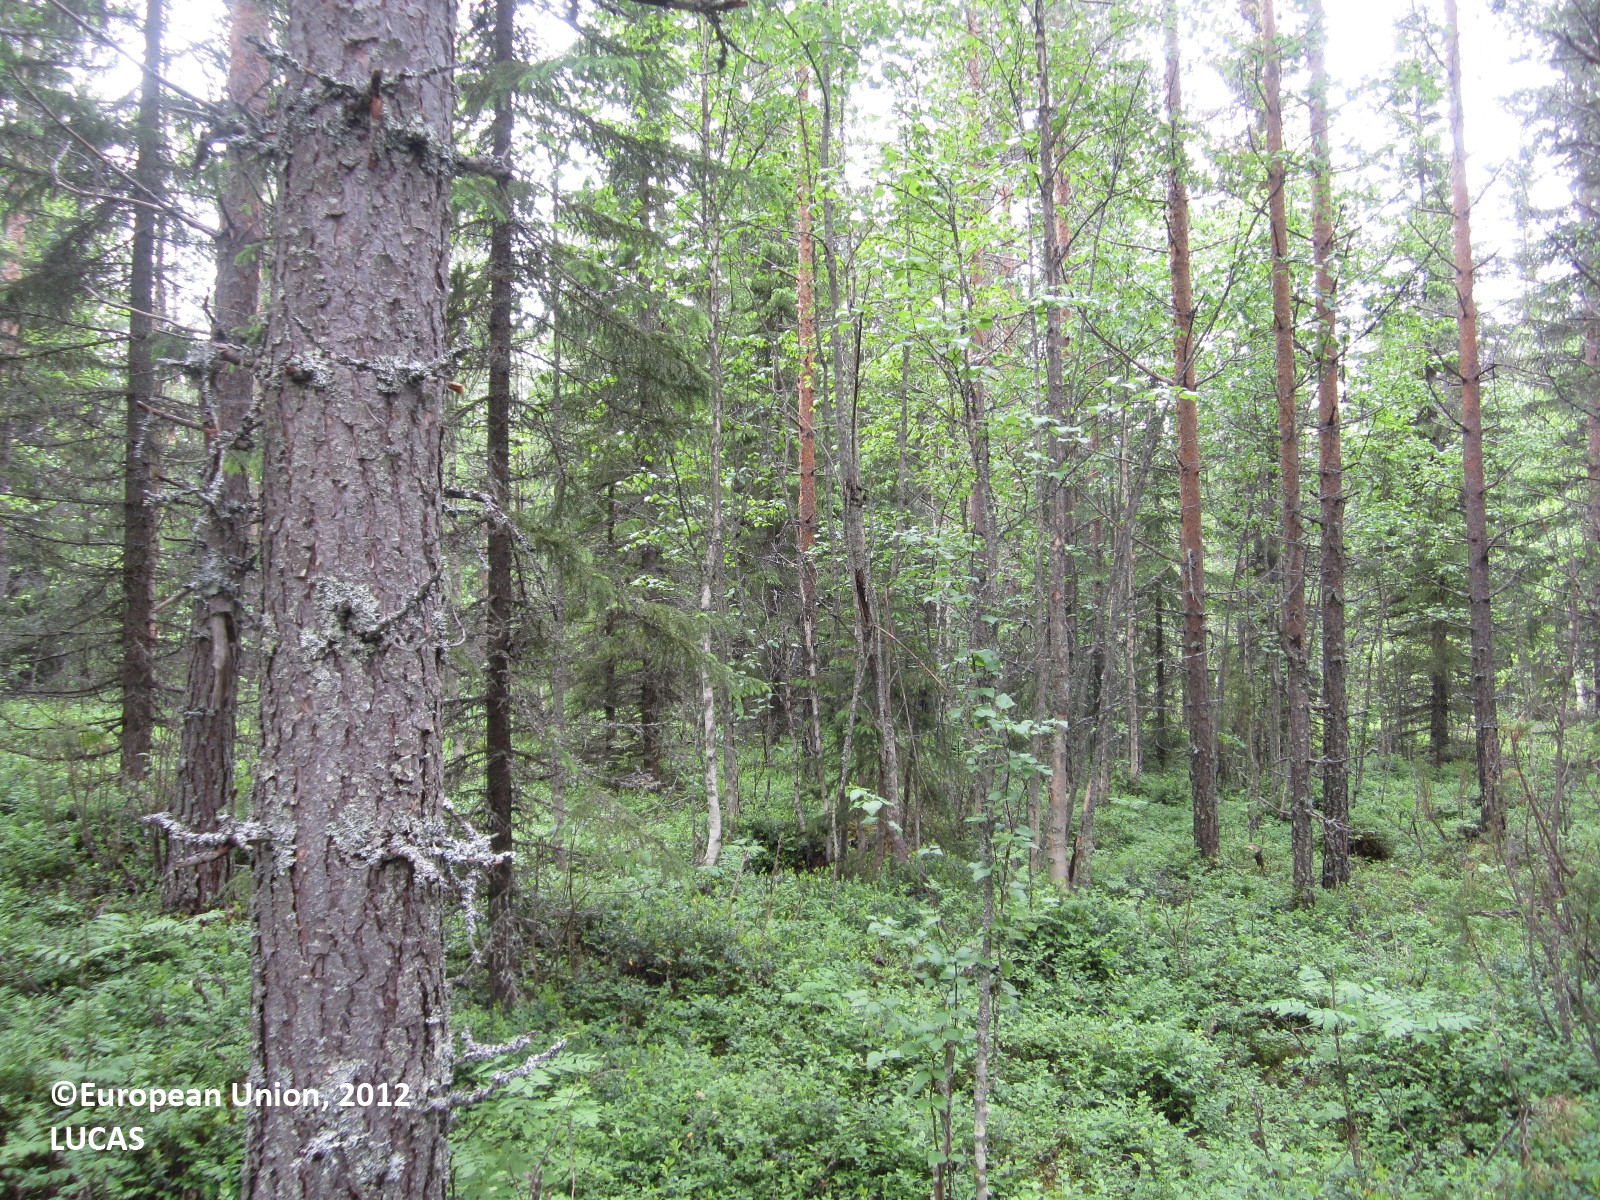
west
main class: Woodland
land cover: Other coniferous woodland
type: boreal forest
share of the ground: > 75 %
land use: Forestry
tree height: > 5 m
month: June
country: FI
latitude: 64.3440
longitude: 29.8327
